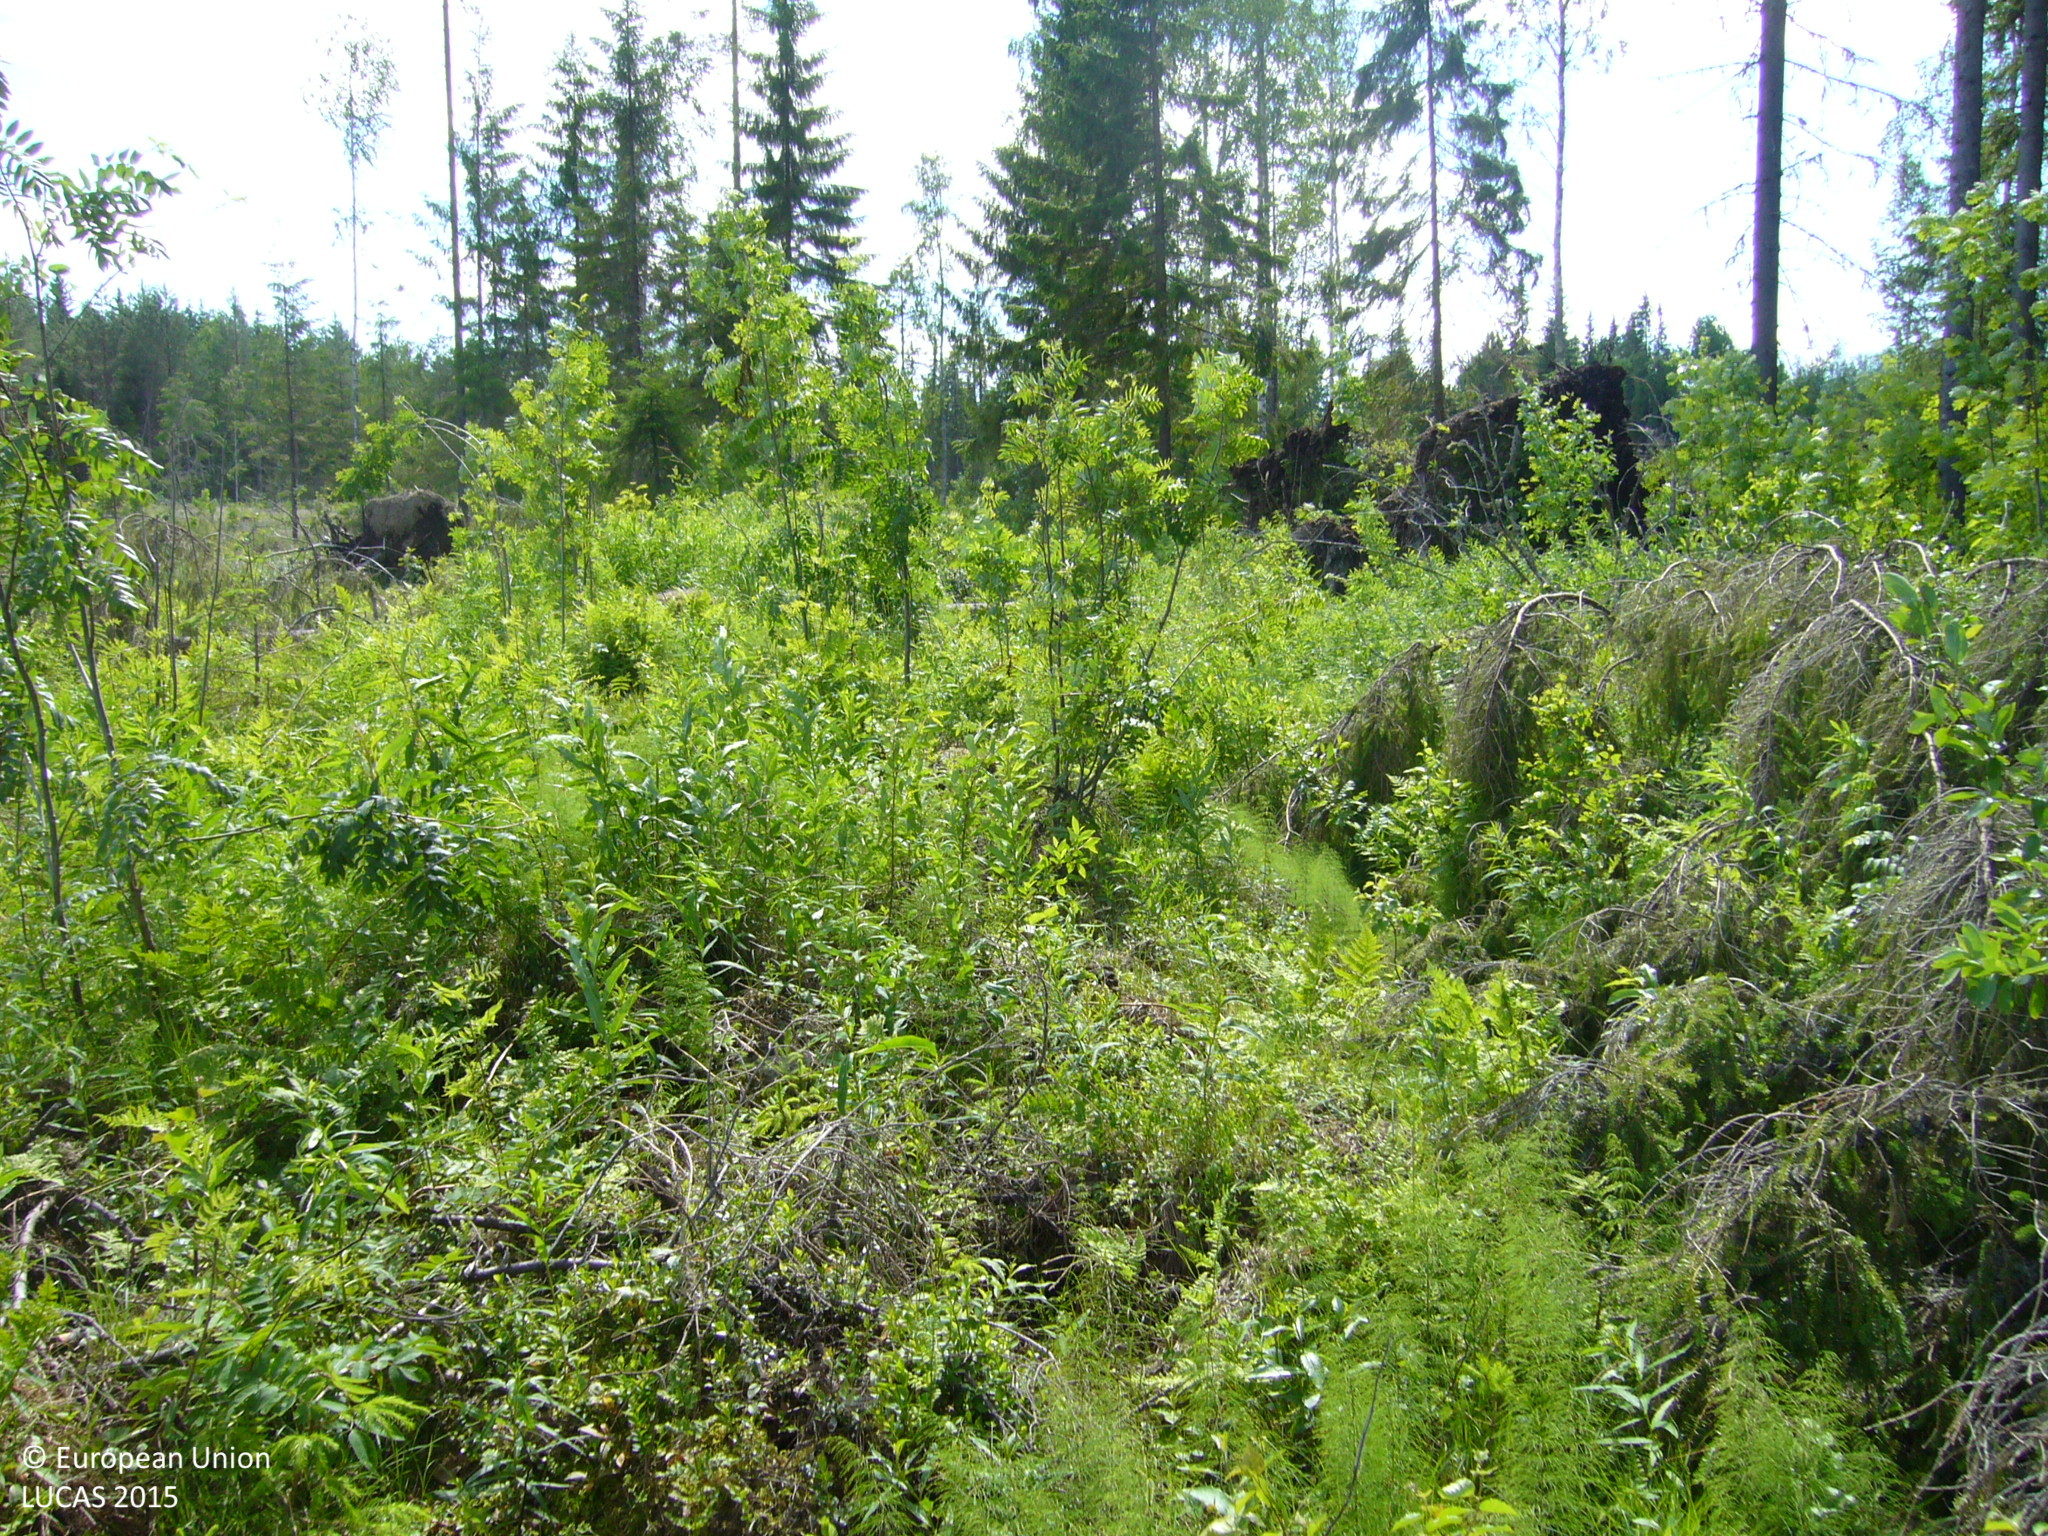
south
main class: Shrubland
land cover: Shrubland without tree cover
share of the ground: 10 - 25 %
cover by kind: herbaceous plants 50 %, shrubs 20 %, consolidated bare surface 10 %, unconsolidated bare surface 10 %
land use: Forestry
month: July
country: FI
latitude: 63.5387
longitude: 26.0247
